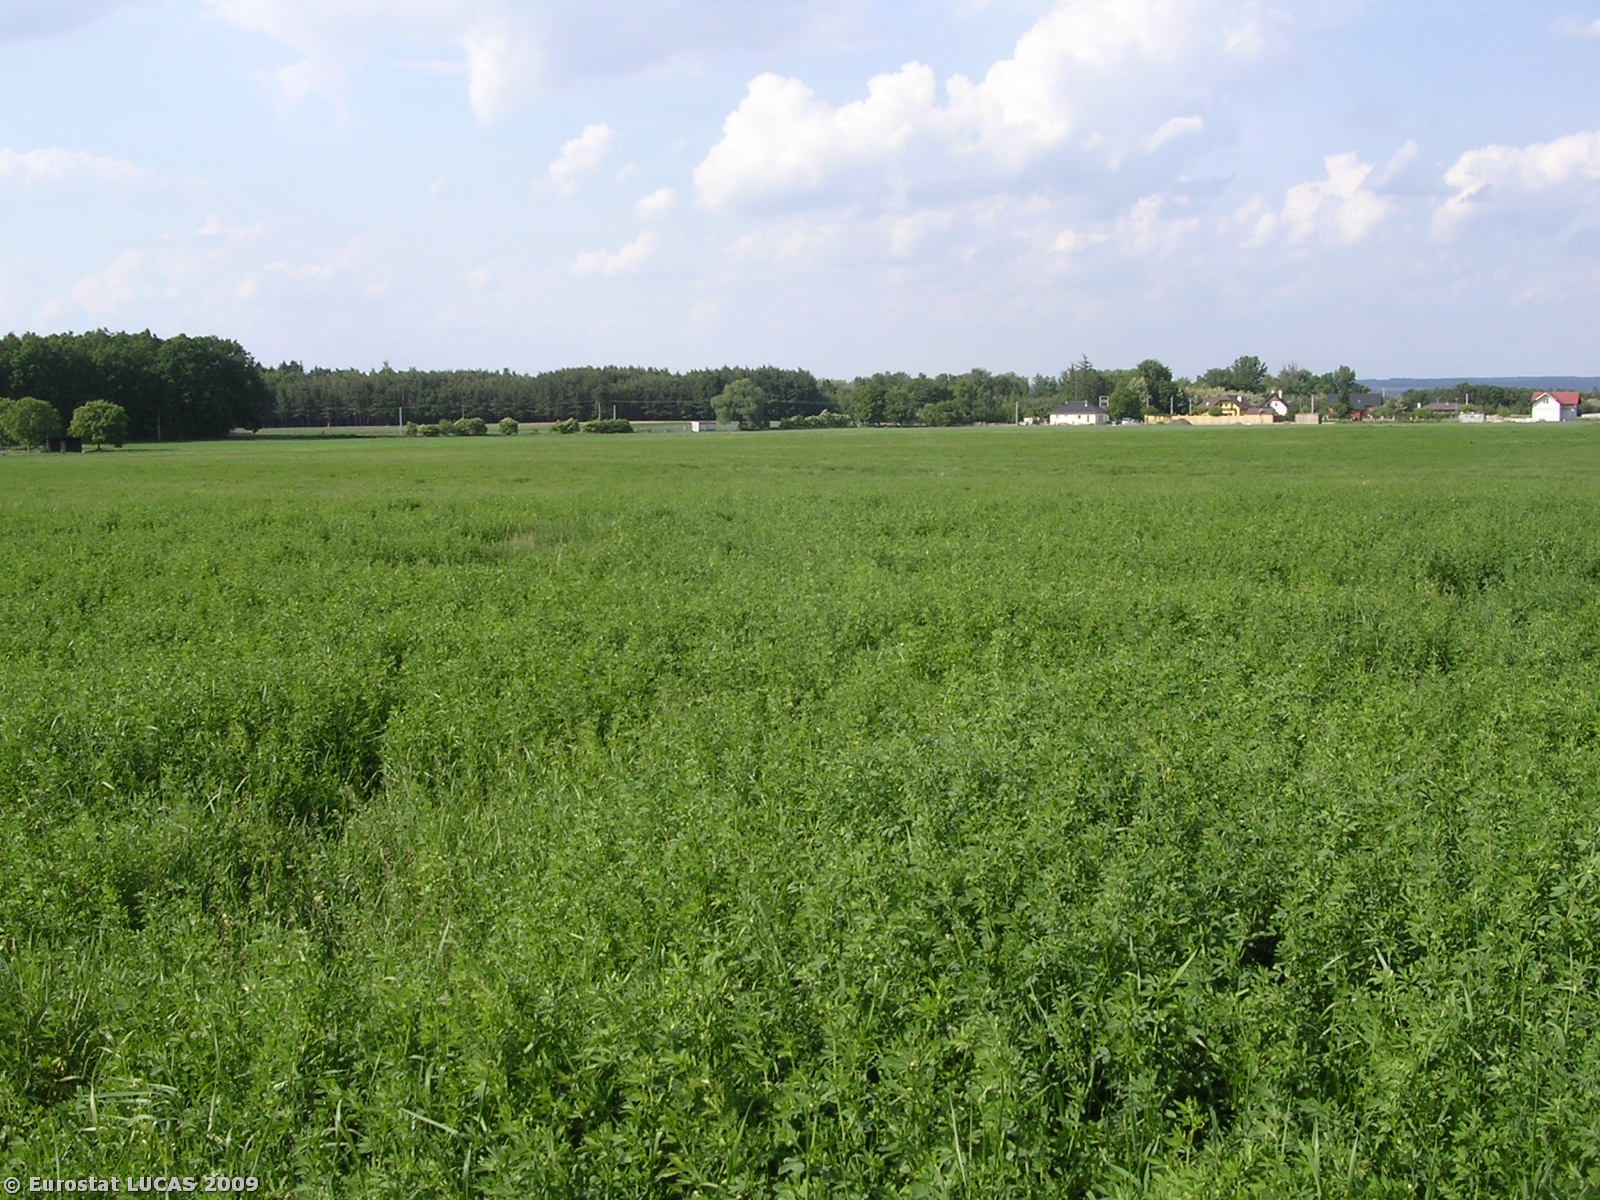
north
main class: Cropland
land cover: Lucerne
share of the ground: > 75 %
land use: Agriculture (excluding fallow land and kitchen gardens)
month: May
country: CZ
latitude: 50.2170
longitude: 14.6127
